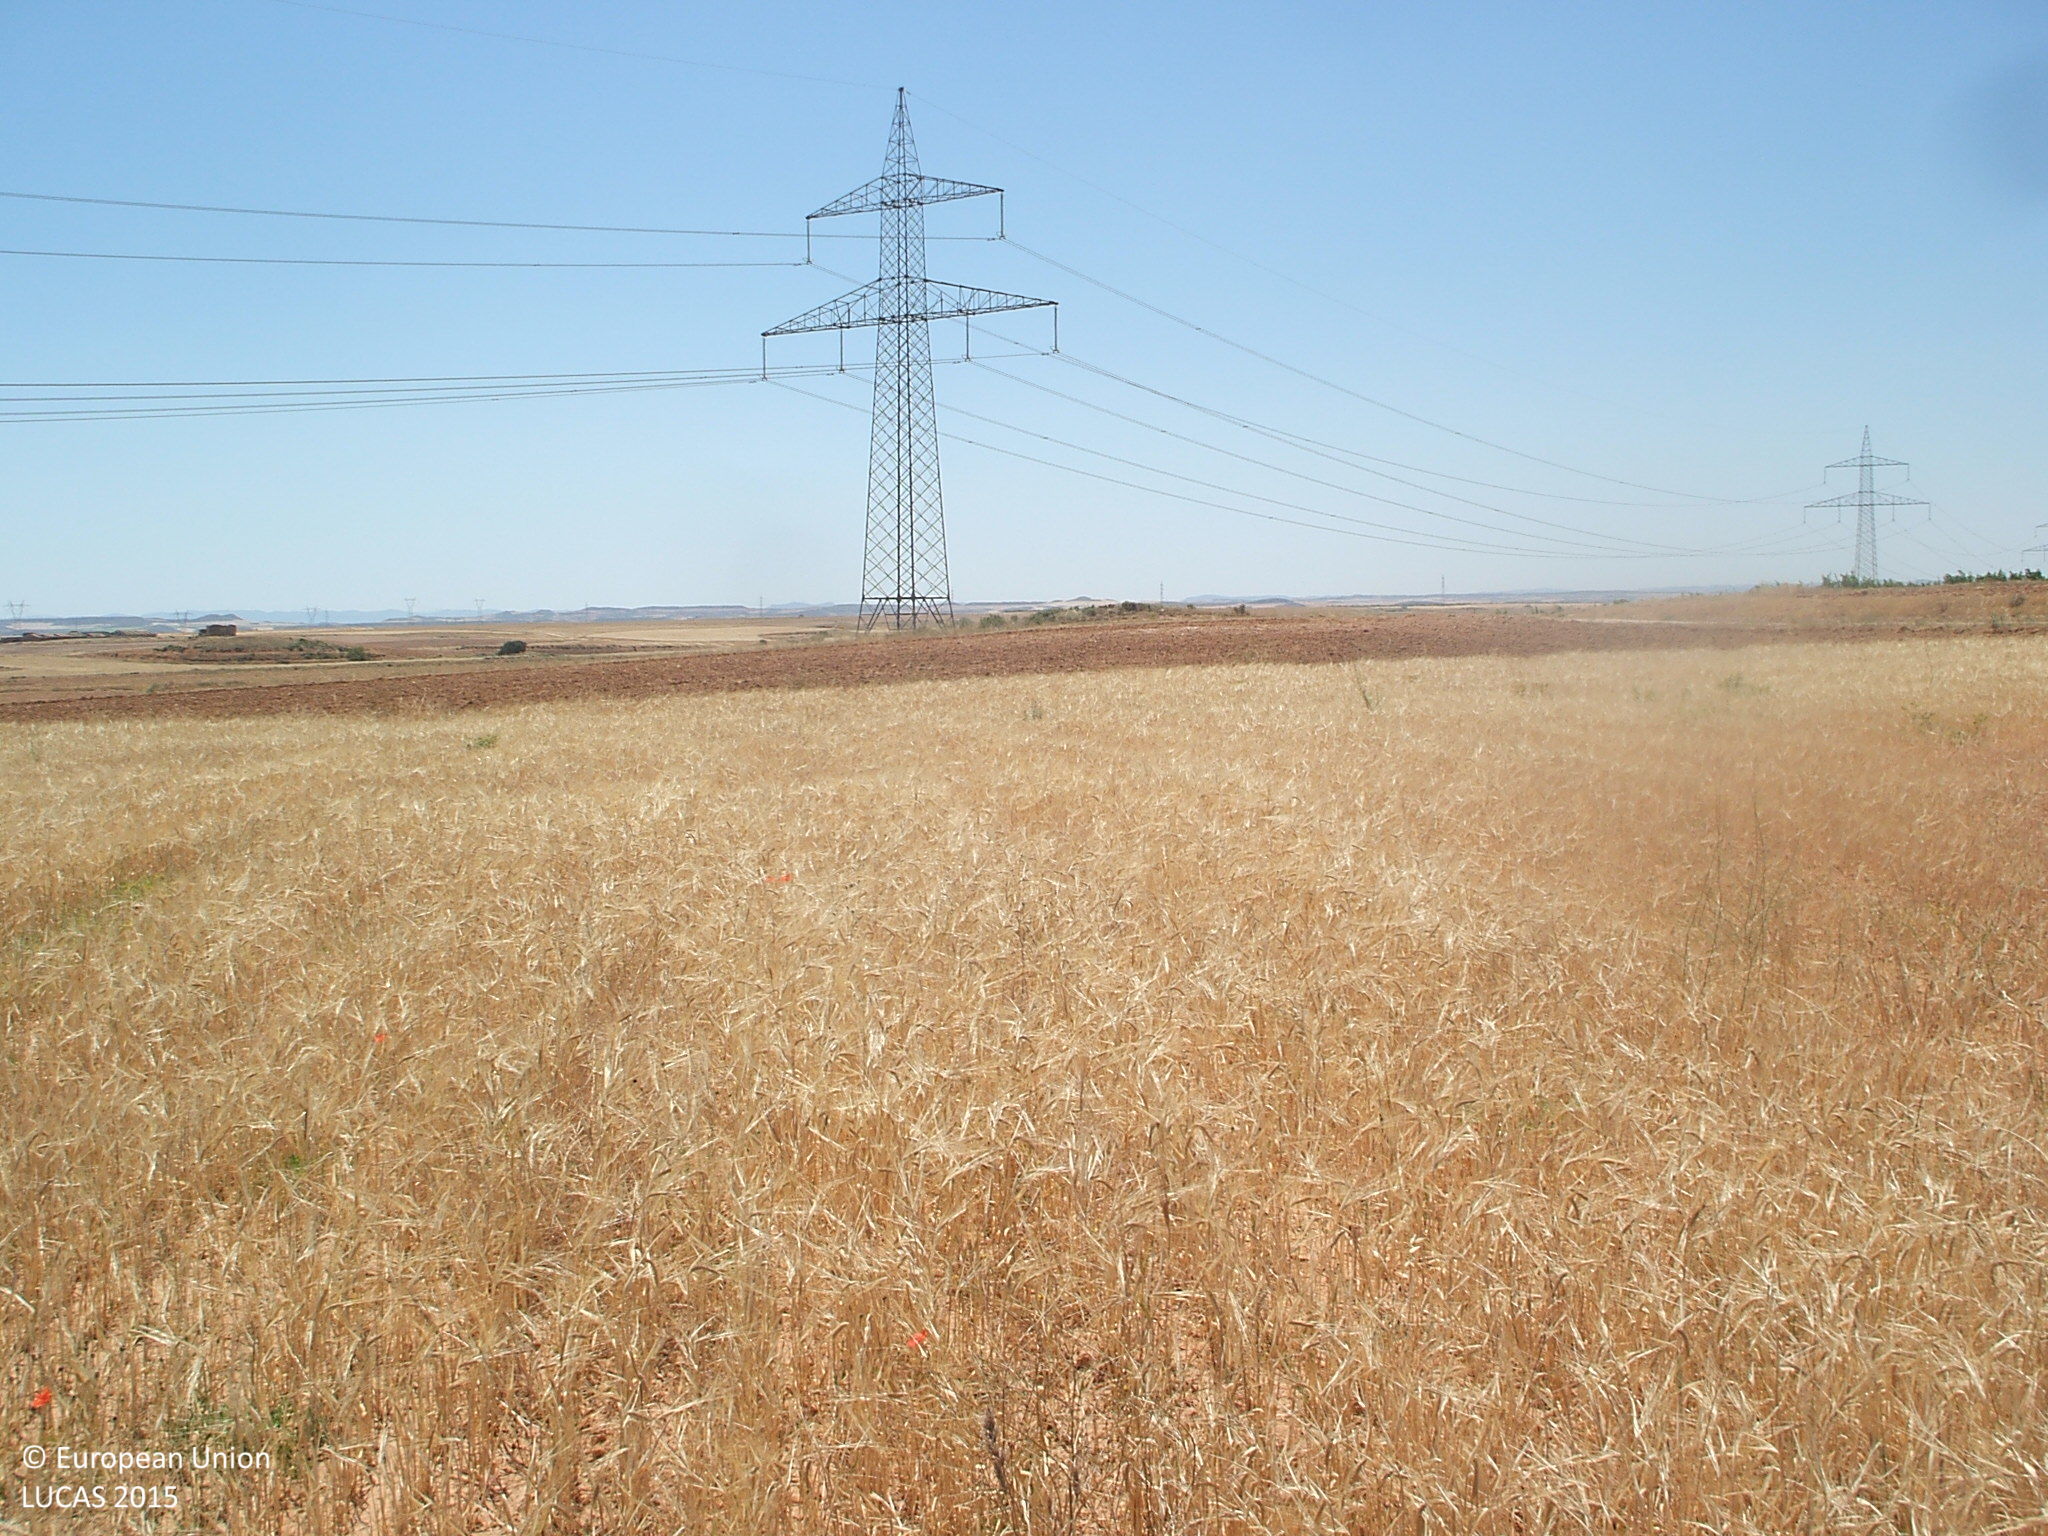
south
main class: Cropland
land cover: Barley
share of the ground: > 75 %
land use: Agriculture (excluding fallow land and kitchen gardens)
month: June
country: ES
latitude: 41.1428
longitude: -0.3191
